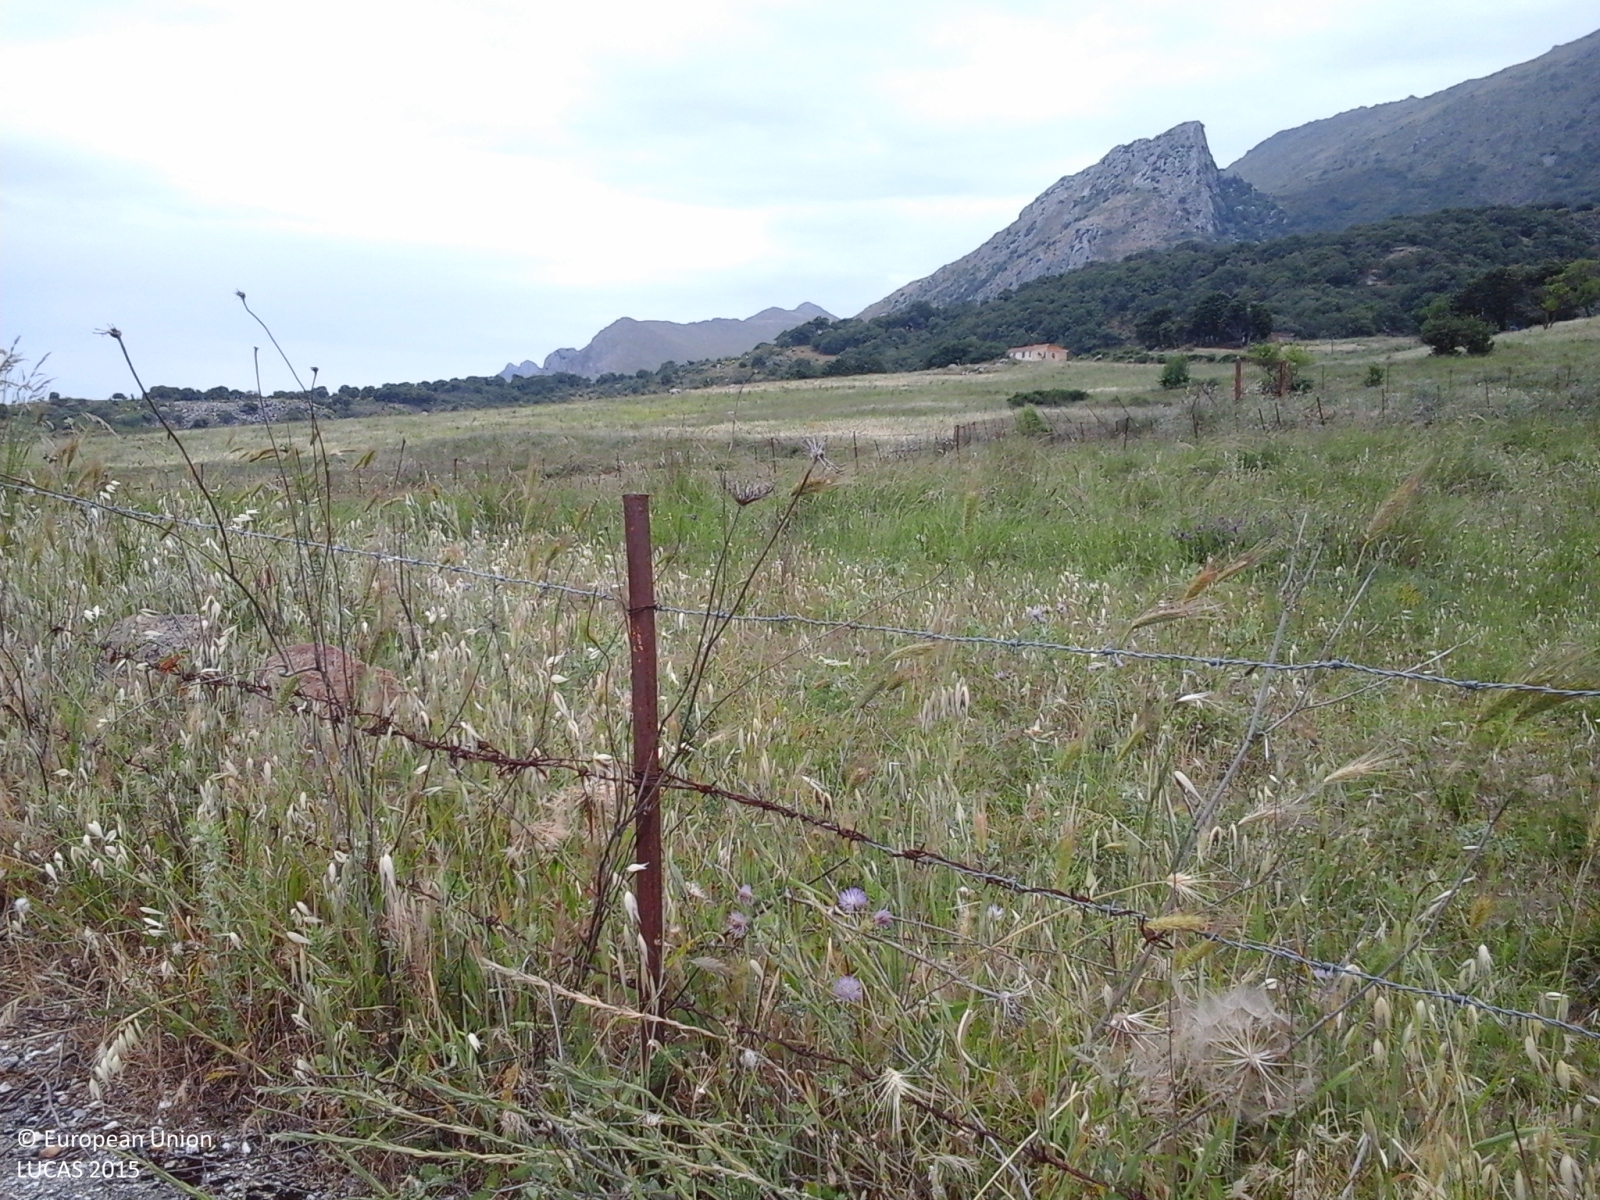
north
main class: Cropland
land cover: Other leguminous and mixtures for fodder
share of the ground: > 75 %
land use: Agriculture (excluding fallow land and kitchen gardens)
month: May
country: IT
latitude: 37.9353
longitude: 13.5587
